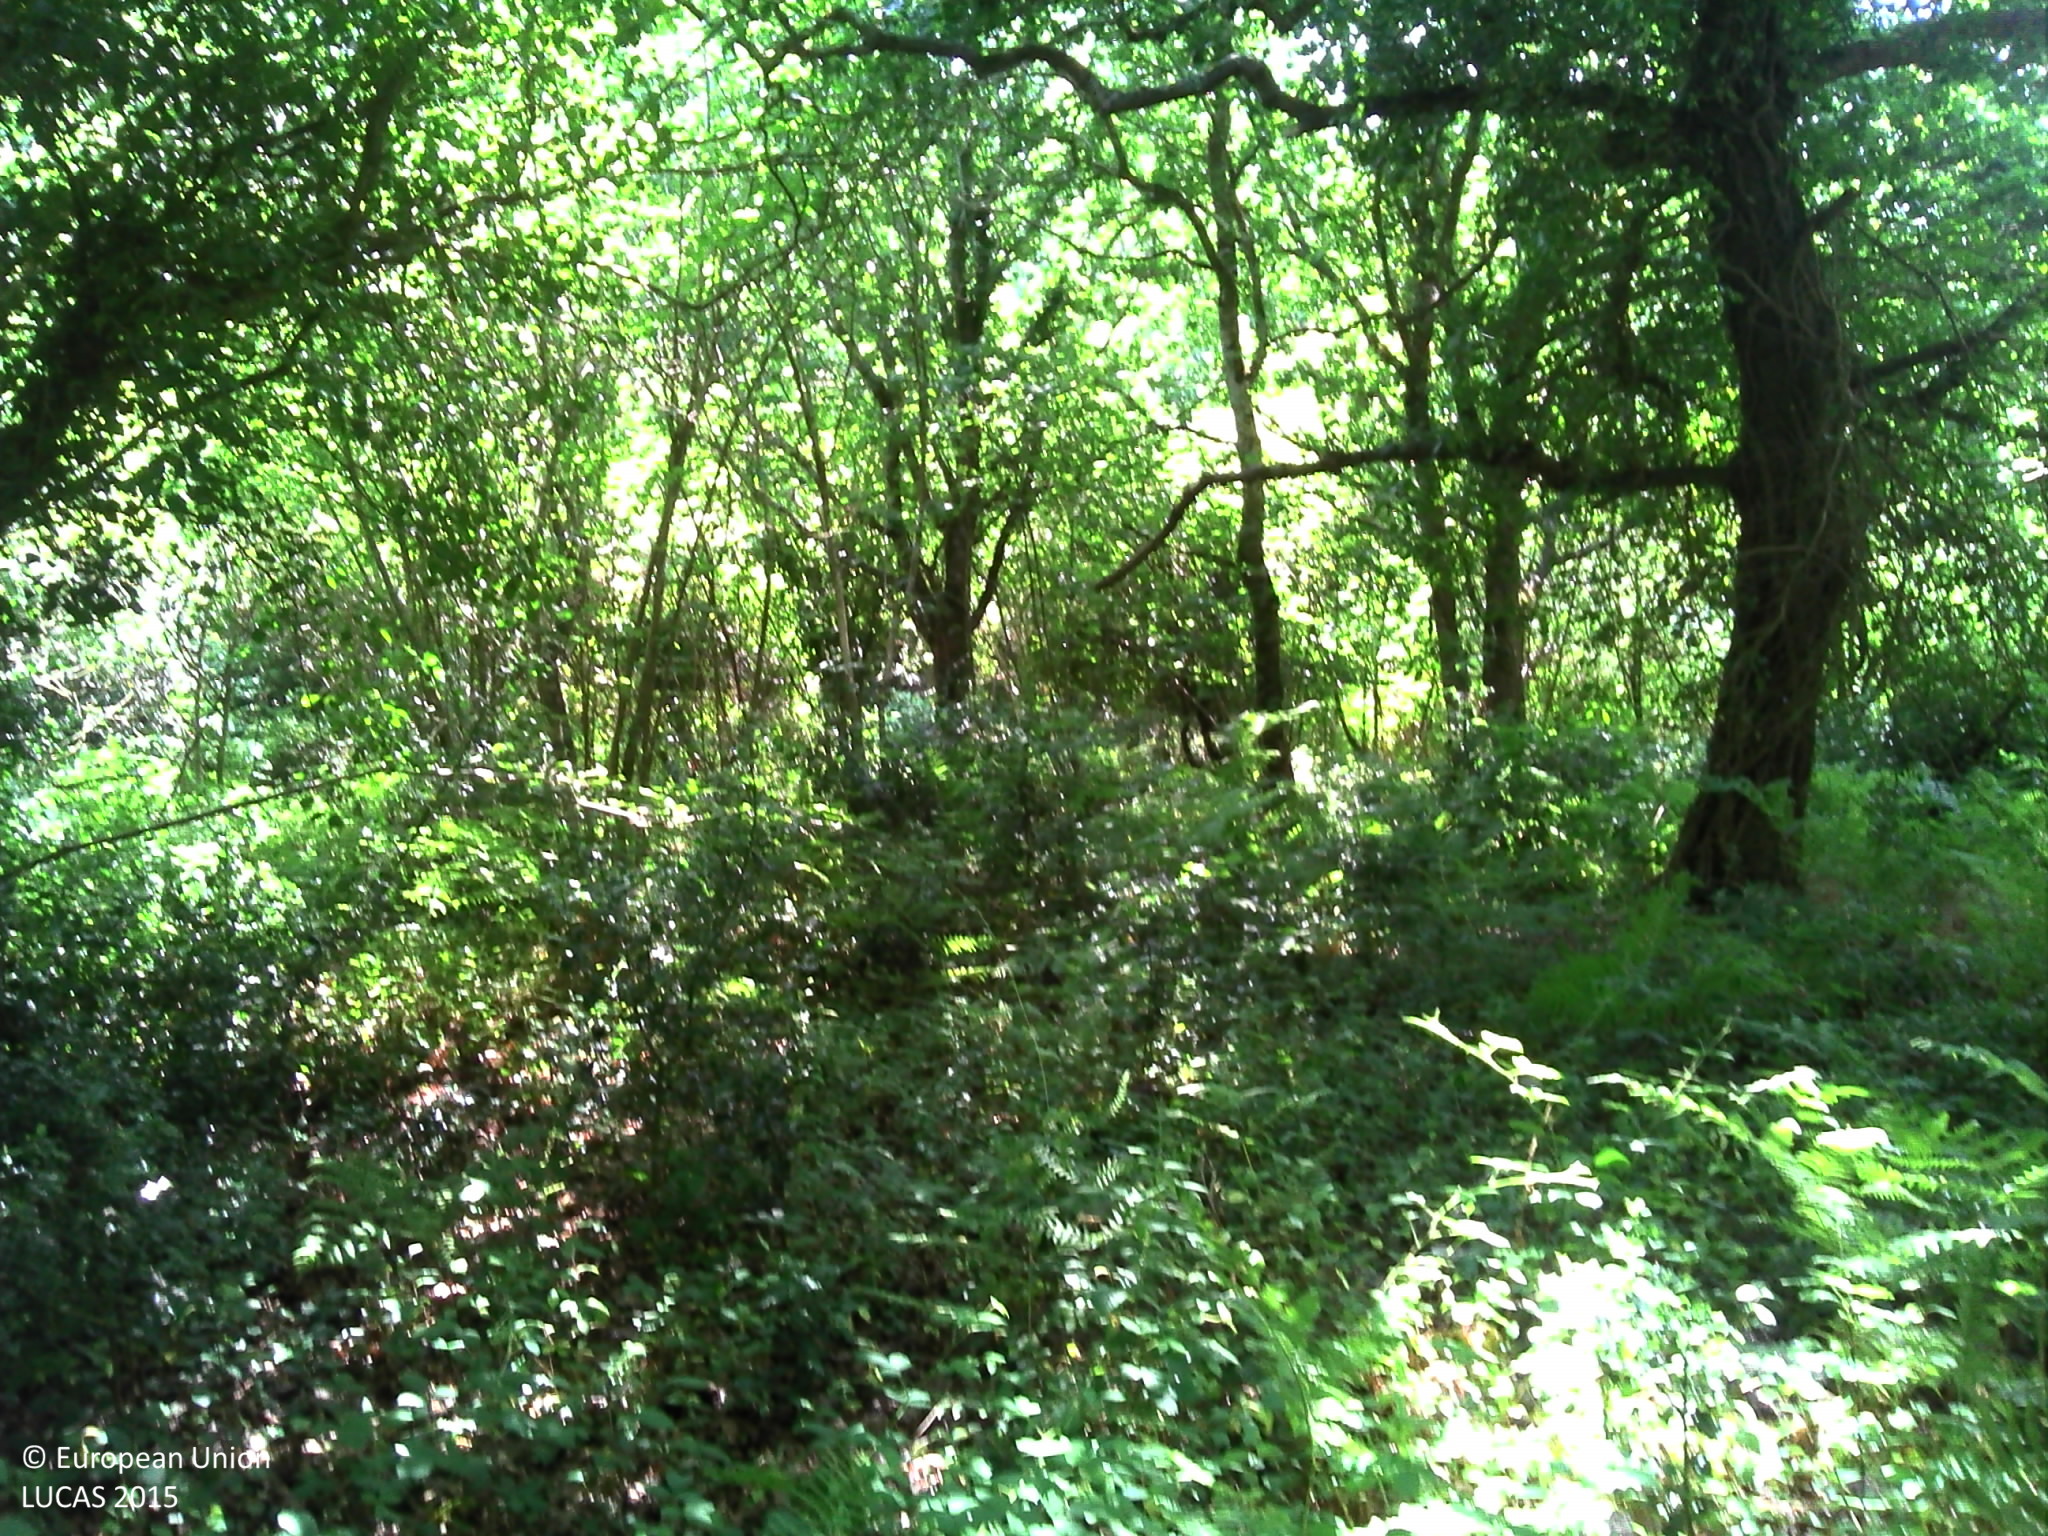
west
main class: Woodland
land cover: Broadleaved woodland
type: mesophytic deciduous forest
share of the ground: > 75 %
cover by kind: herbaceous plants 60 %, broadleaved forest trees 25 %, unconsolidated bare surface 15 %
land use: Forestry
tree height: > 5 m
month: July
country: FR
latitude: 48.7702
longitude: -3.5372
